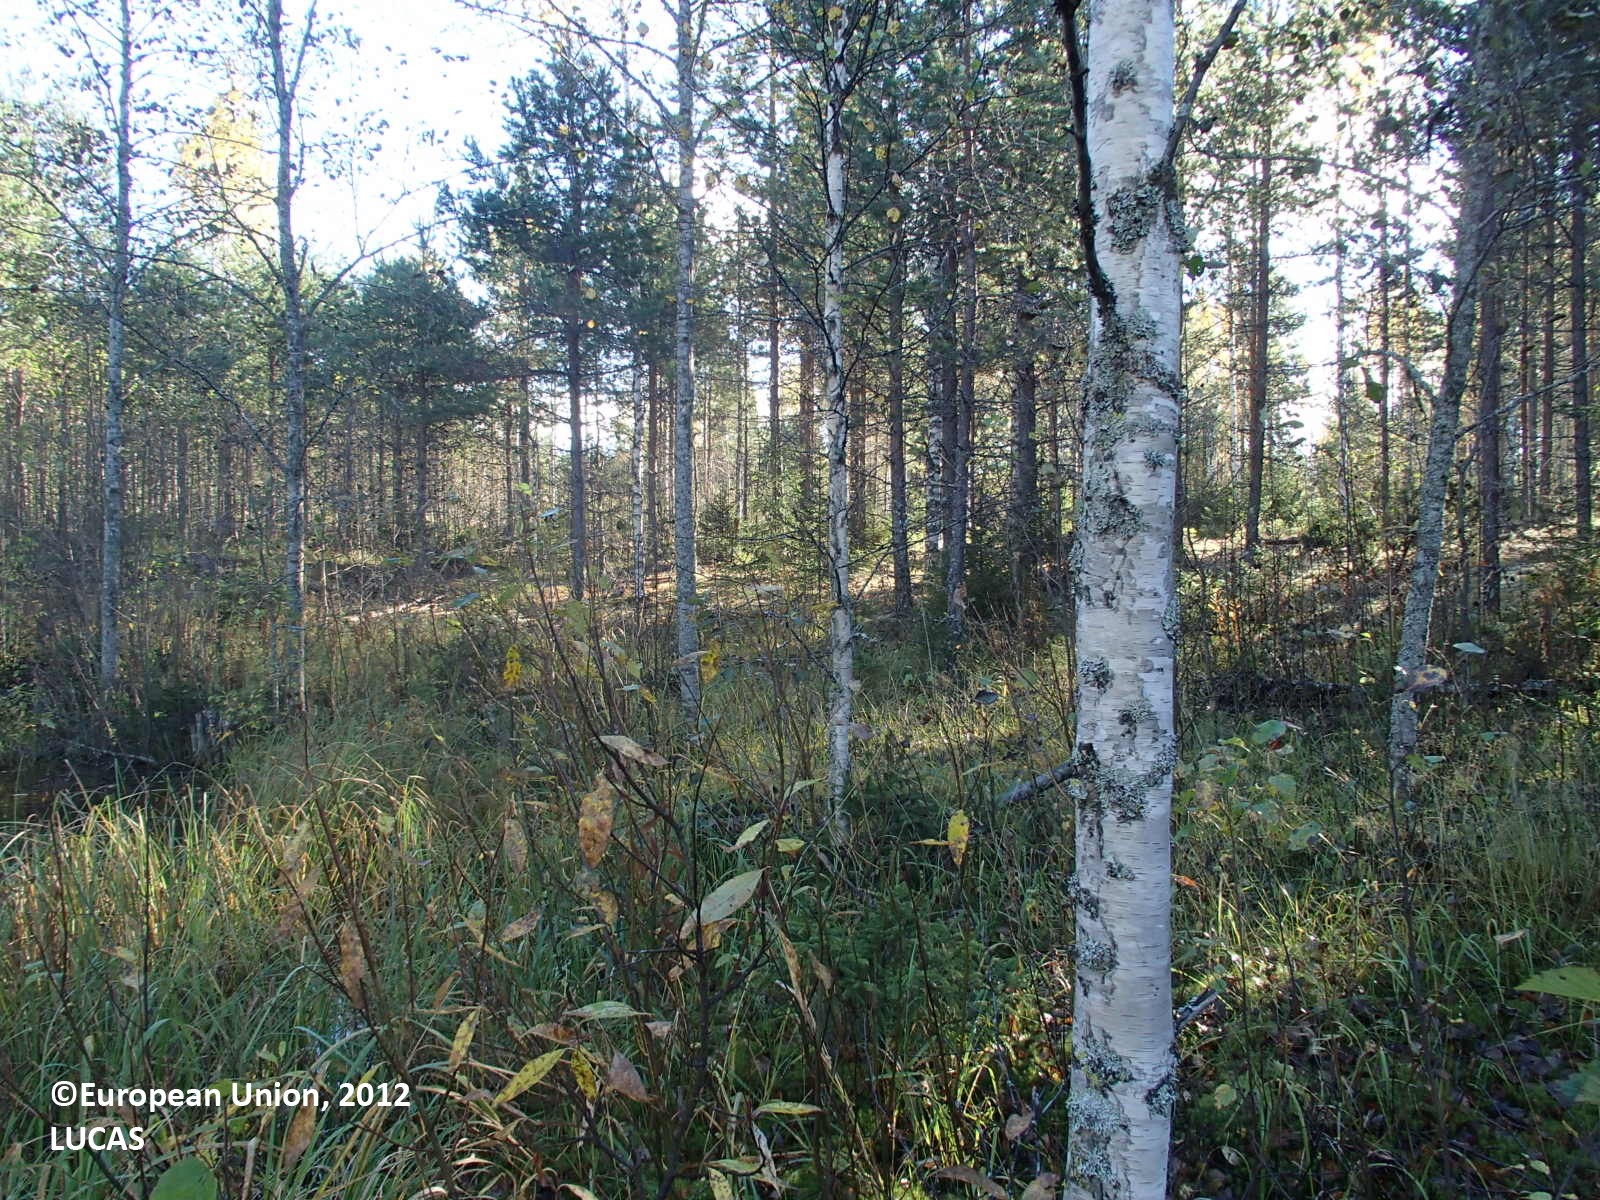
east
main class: Woodland
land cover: Pine dominated mixed woodland
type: boreal forest
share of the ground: 25 - 50 %
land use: Forestry
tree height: > 5 m
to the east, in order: Pine dominated mixed woodland; Inland marshes; Inland water bodies; Pine dominated mixed woodland; Inland marshes; Pine dominated mixed woodland; Inland marshes; Pine dominated mixed woodland; Inland marshes; Pine dominated mixed woodland; Spruce dominated mixed woodland
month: September
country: FI
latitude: 63.4246
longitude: 26.9083
